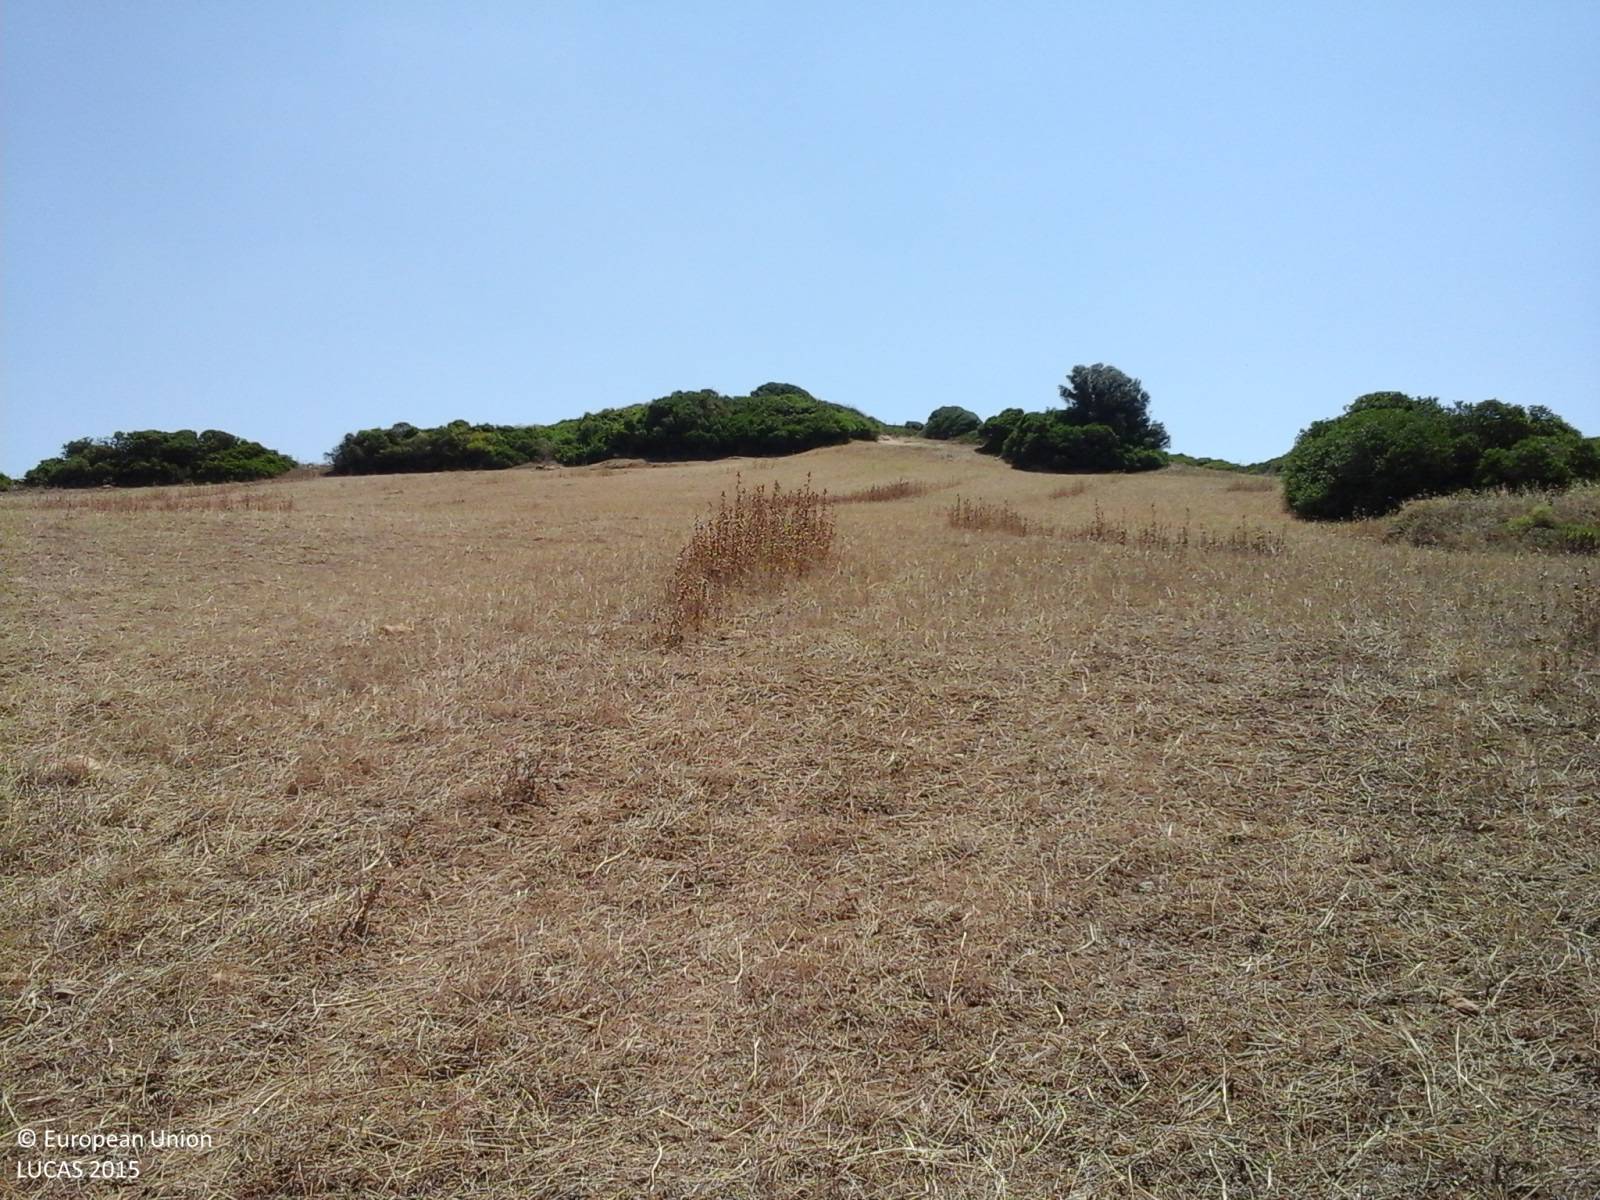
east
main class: Cropland
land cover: Mixed cereals for fodder
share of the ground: > 75 %
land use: Agriculture (excluding fallow land and kitchen gardens)
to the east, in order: Mixed cereals for fodder; Shrubland without tree cover; Fences; Mixed cereals for fodder; Grassland without tree/shrub cover; Mixed cereals for fodder; Shrubland without tree cover
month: June
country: IT
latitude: 39.8798
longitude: 8.8023
